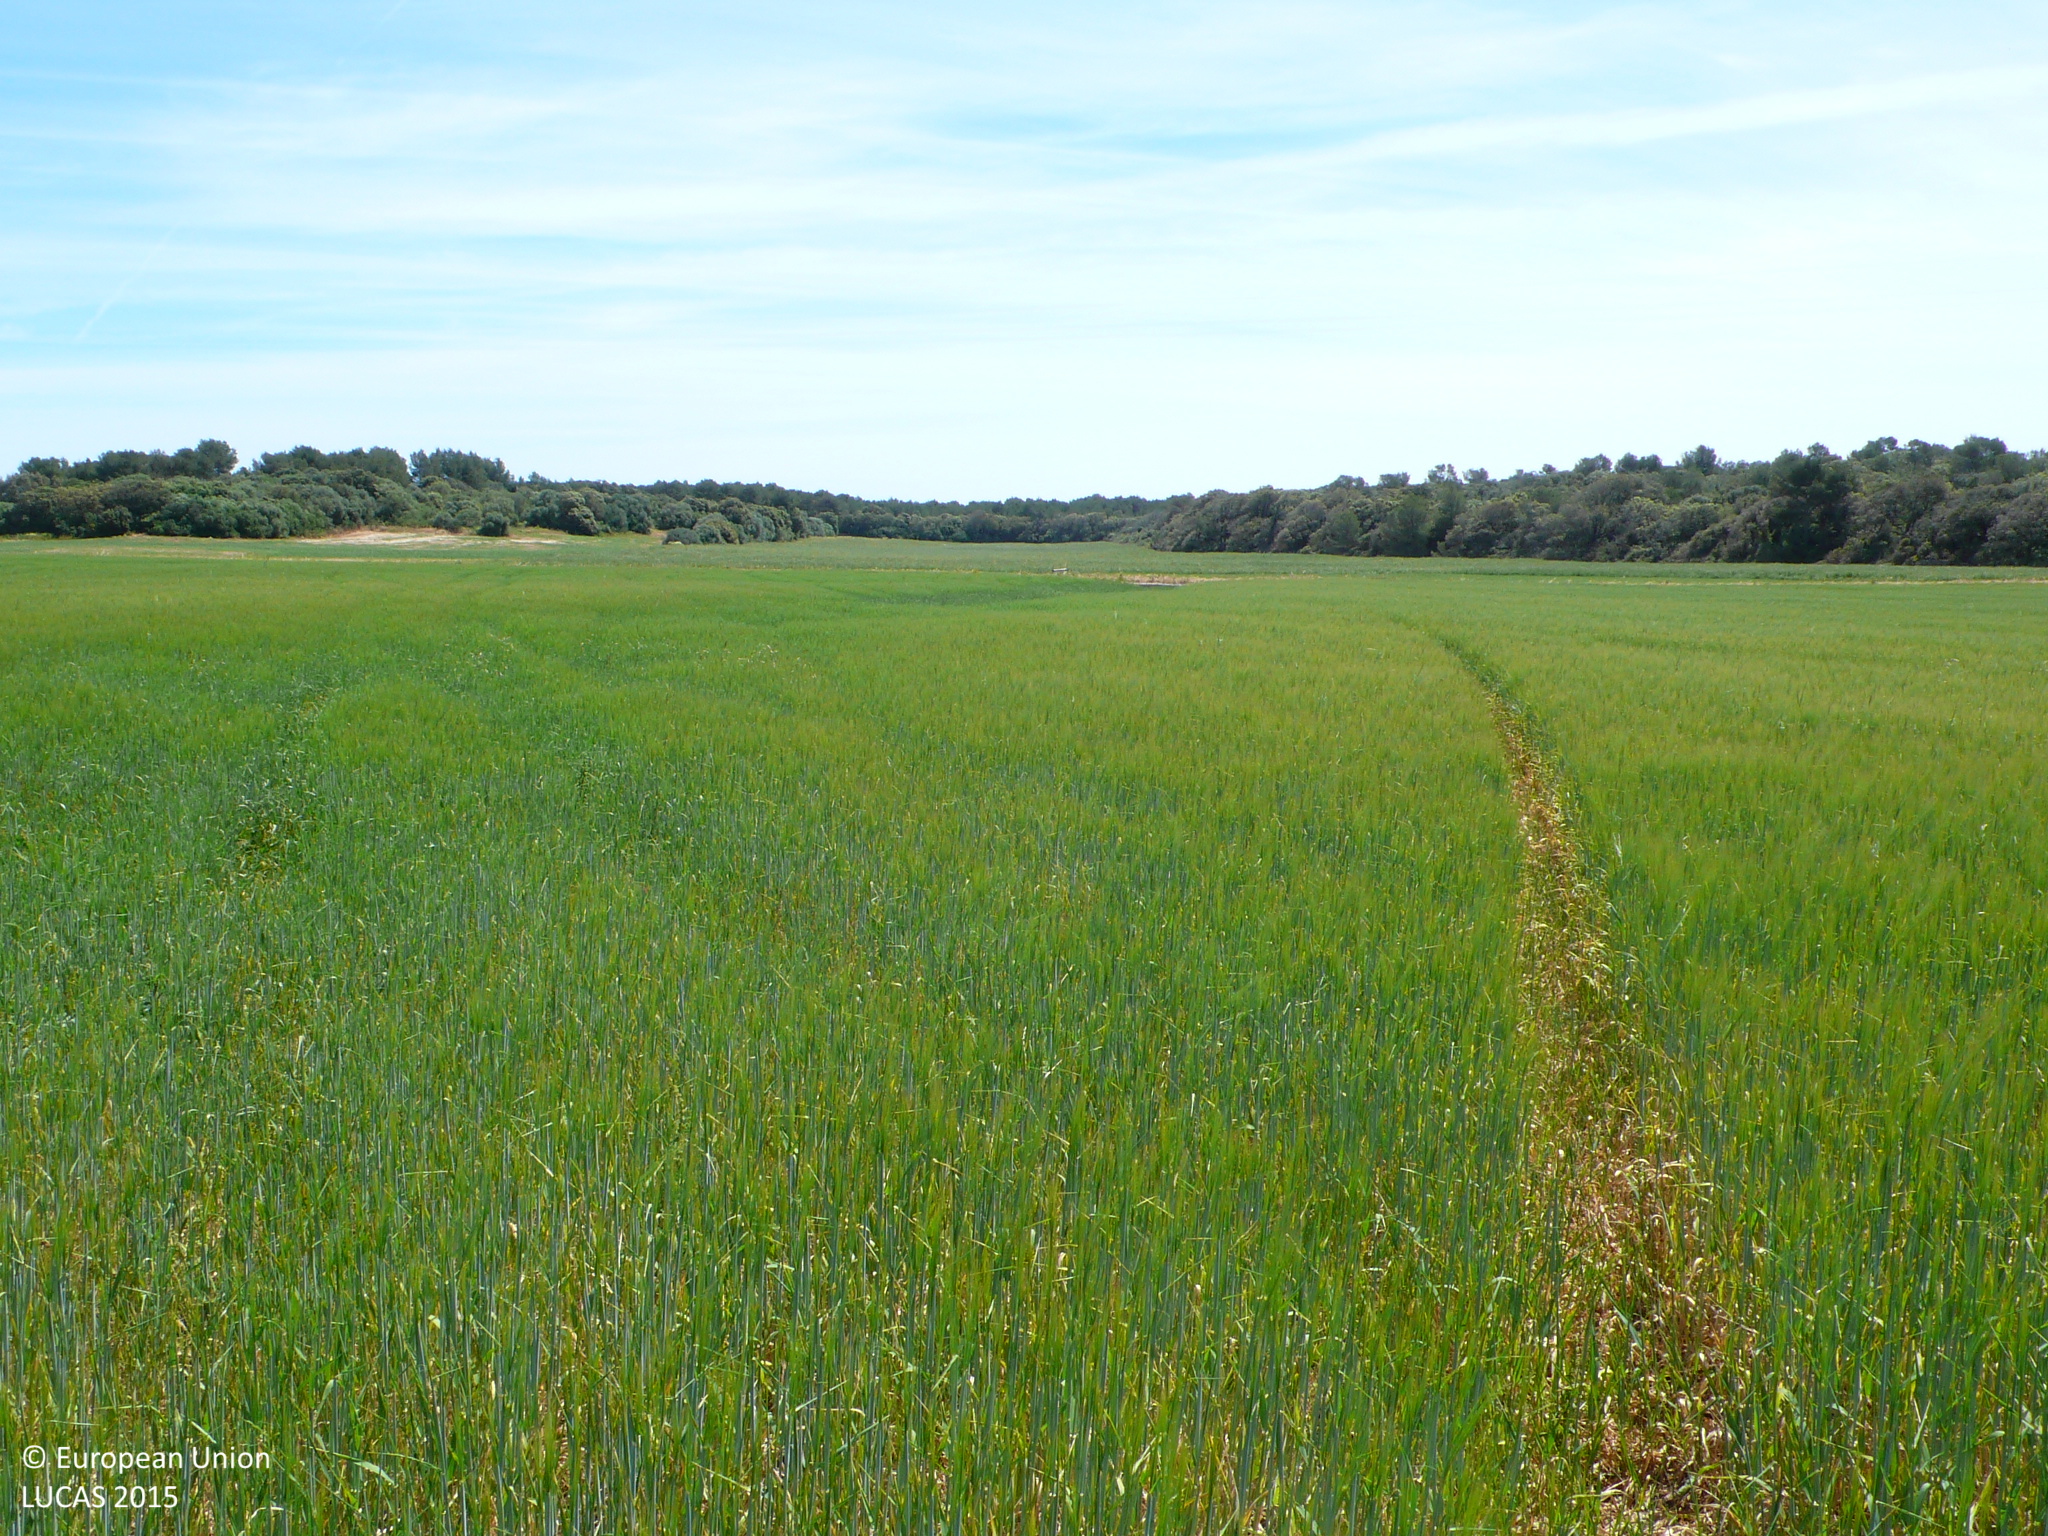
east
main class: Cropland
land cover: Barley
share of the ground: > 75 %
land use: Agriculture (excluding fallow land and kitchen gardens)
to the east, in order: Barley; Electric lines; Barley; Grass margins; Tracks; Grass margins; Mixed cereals for fodder
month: May
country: ES
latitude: 39.9663
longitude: 4.1604
